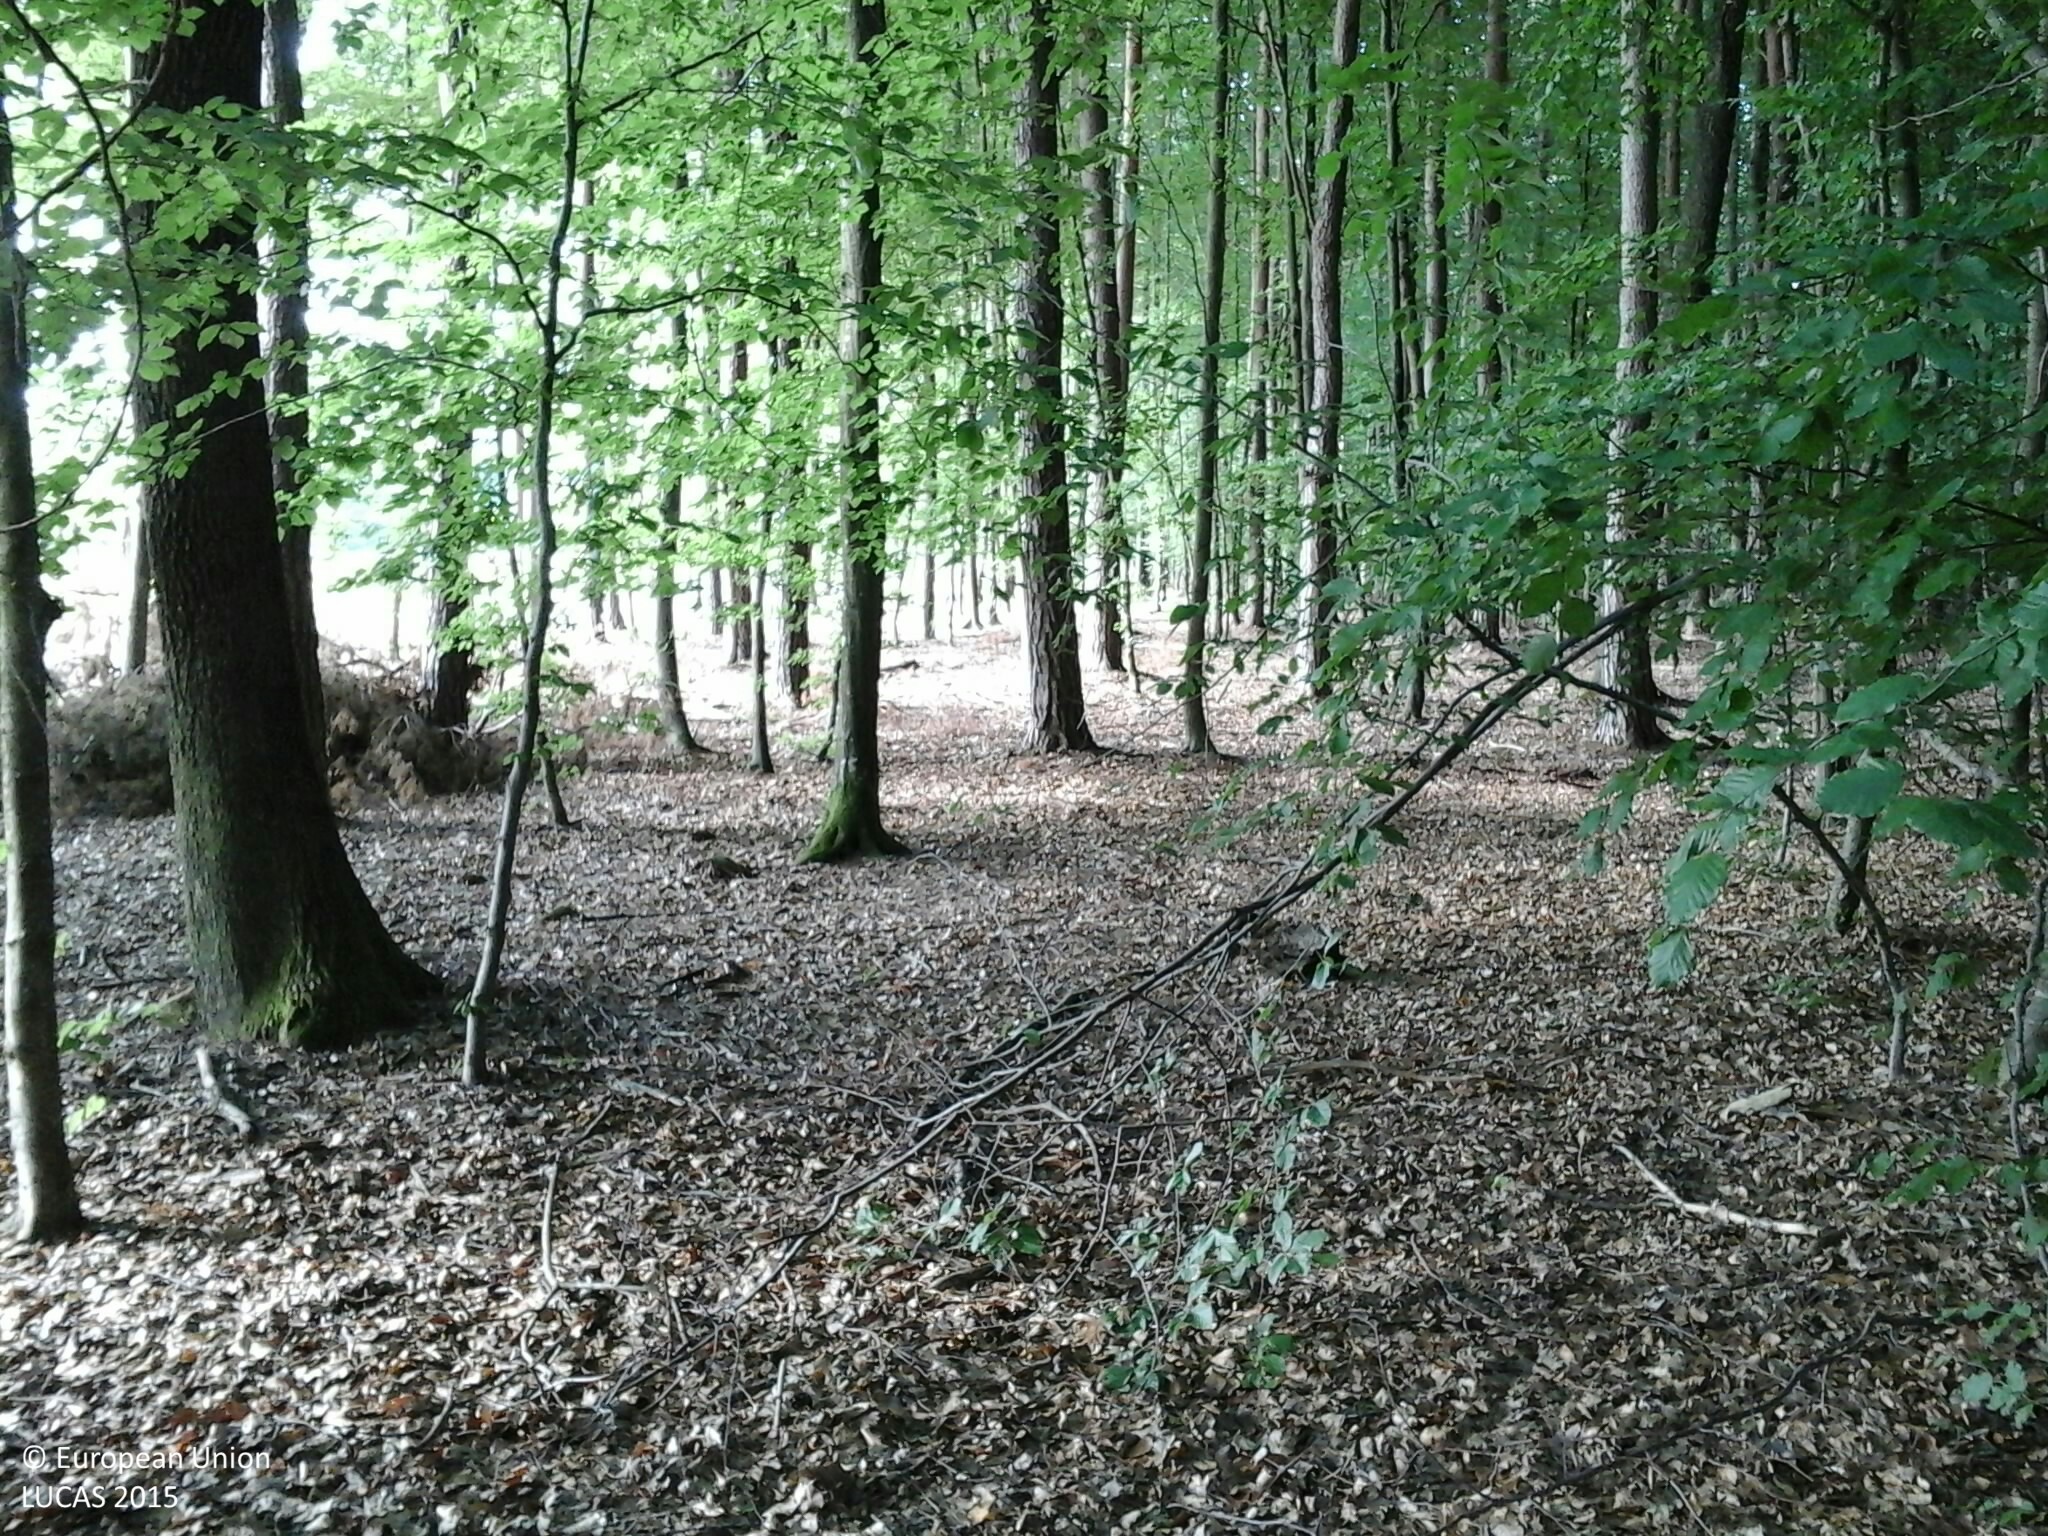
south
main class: Woodland
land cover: Broadleaved woodland
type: mesophytic deciduous forest
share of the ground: > 75 %
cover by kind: broadleaved forest trees 70 %, coniferous forest trees 20 %, shrubs 5 %, herbaceous plants 5 %
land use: Forestry
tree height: > 5 m
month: July
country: HU
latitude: 46.8794
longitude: 16.4447
